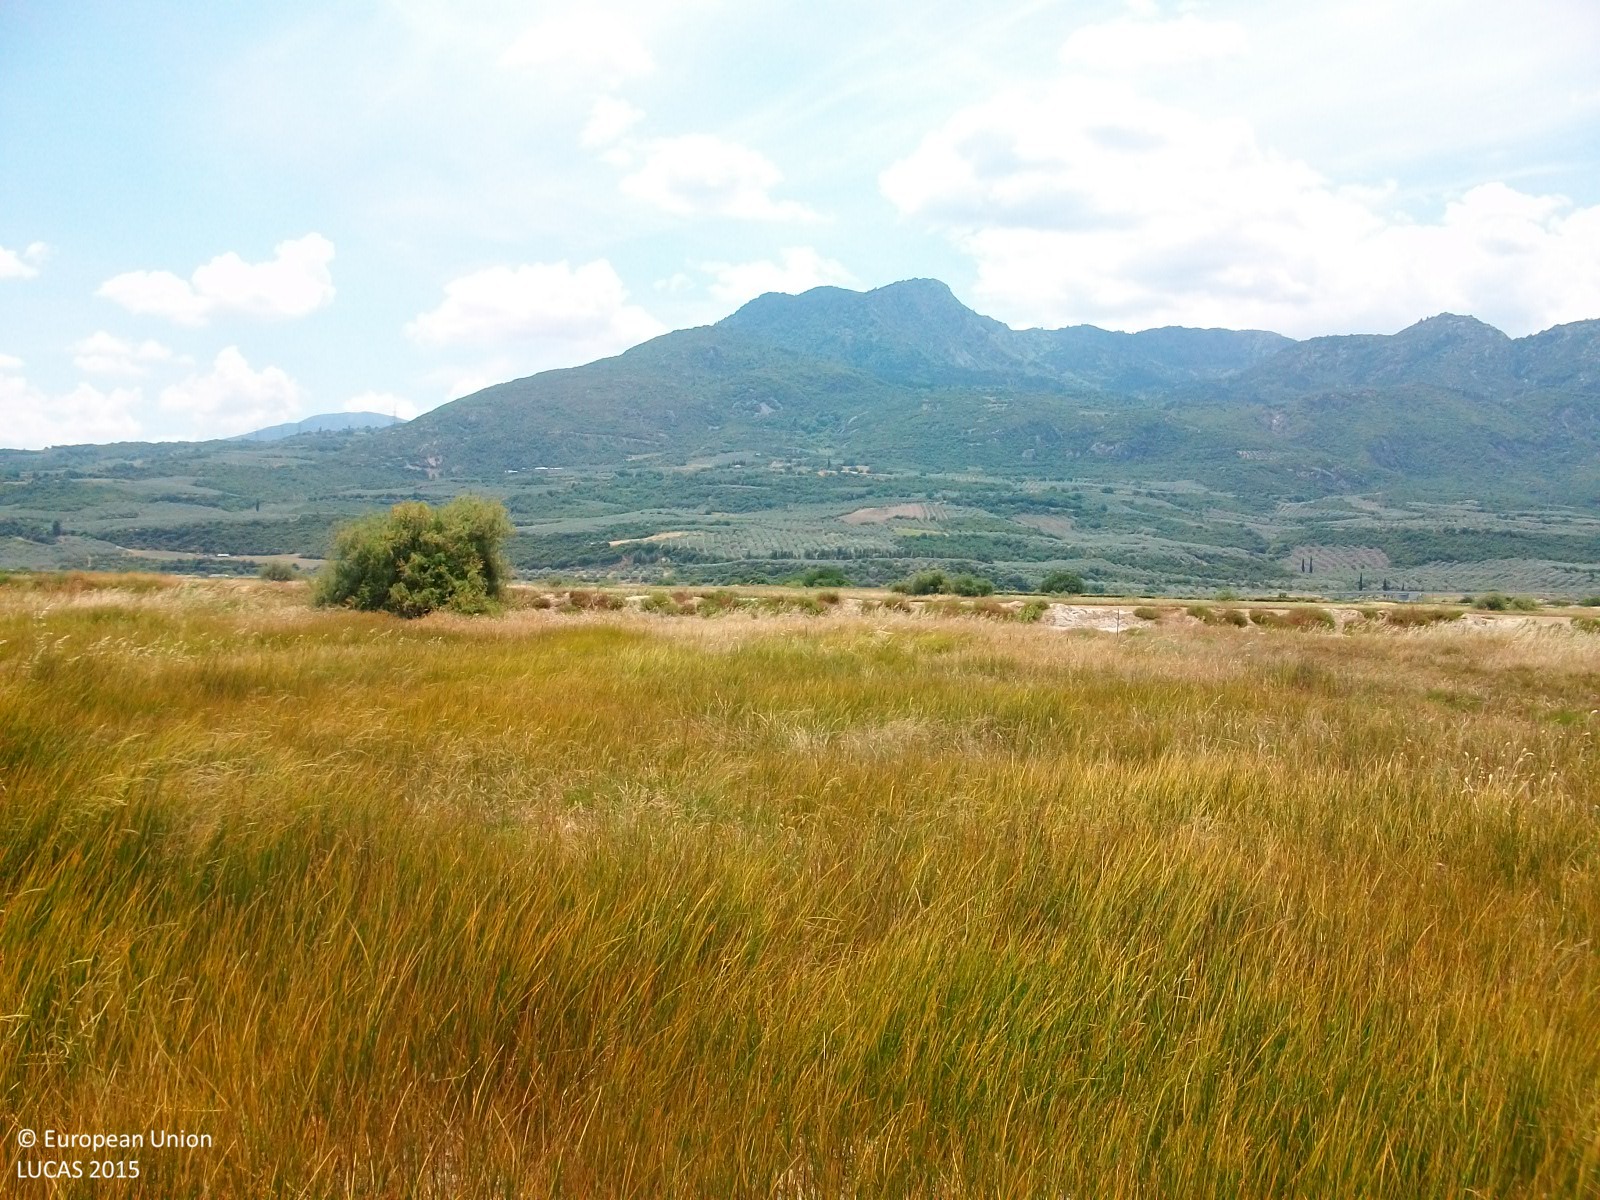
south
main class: Grassland
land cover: Spontaneously vegetated surfaces
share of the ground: > 75 %
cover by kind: herbaceous plants 100 %
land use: Fallow land
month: June
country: GR
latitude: 38.8152
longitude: 22.5686
